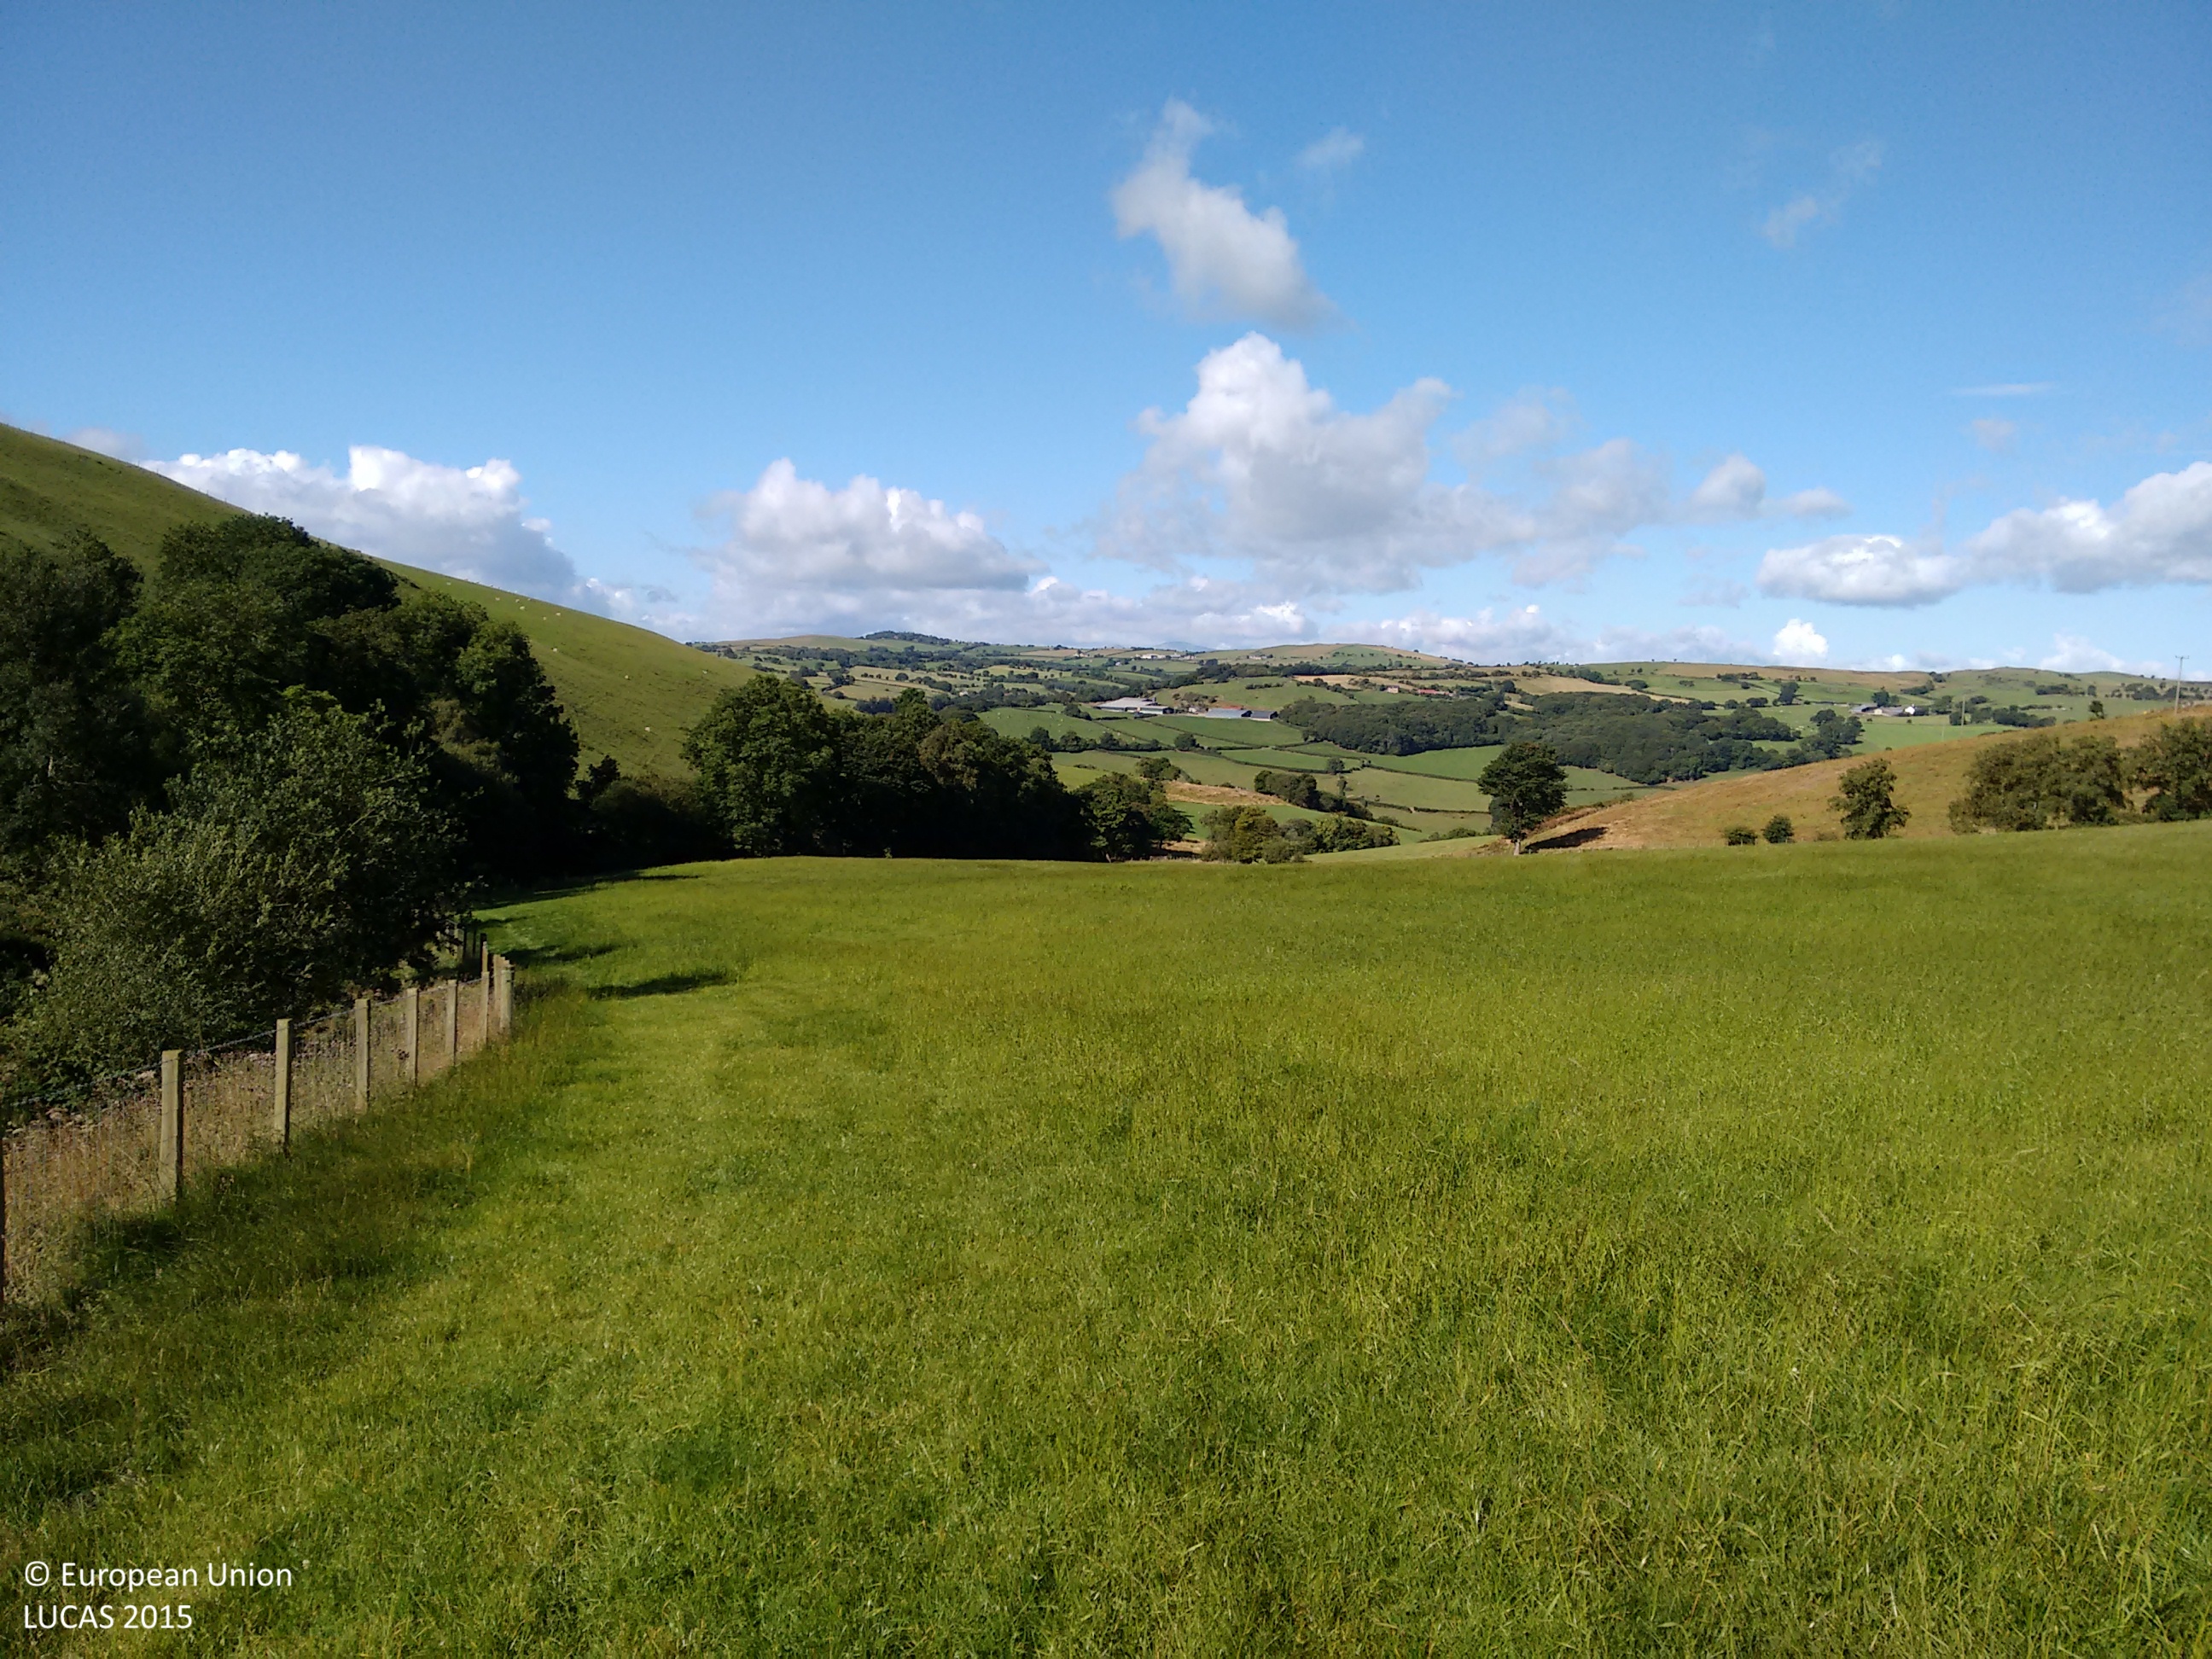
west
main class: Grassland
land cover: Grassland without tree/shrub cover
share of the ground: > 75 %
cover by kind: herbaceous plants 100 %
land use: Agriculture (excluding fallow land and kitchen gardens)
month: August
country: GB
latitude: 53.2020
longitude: -3.5433
